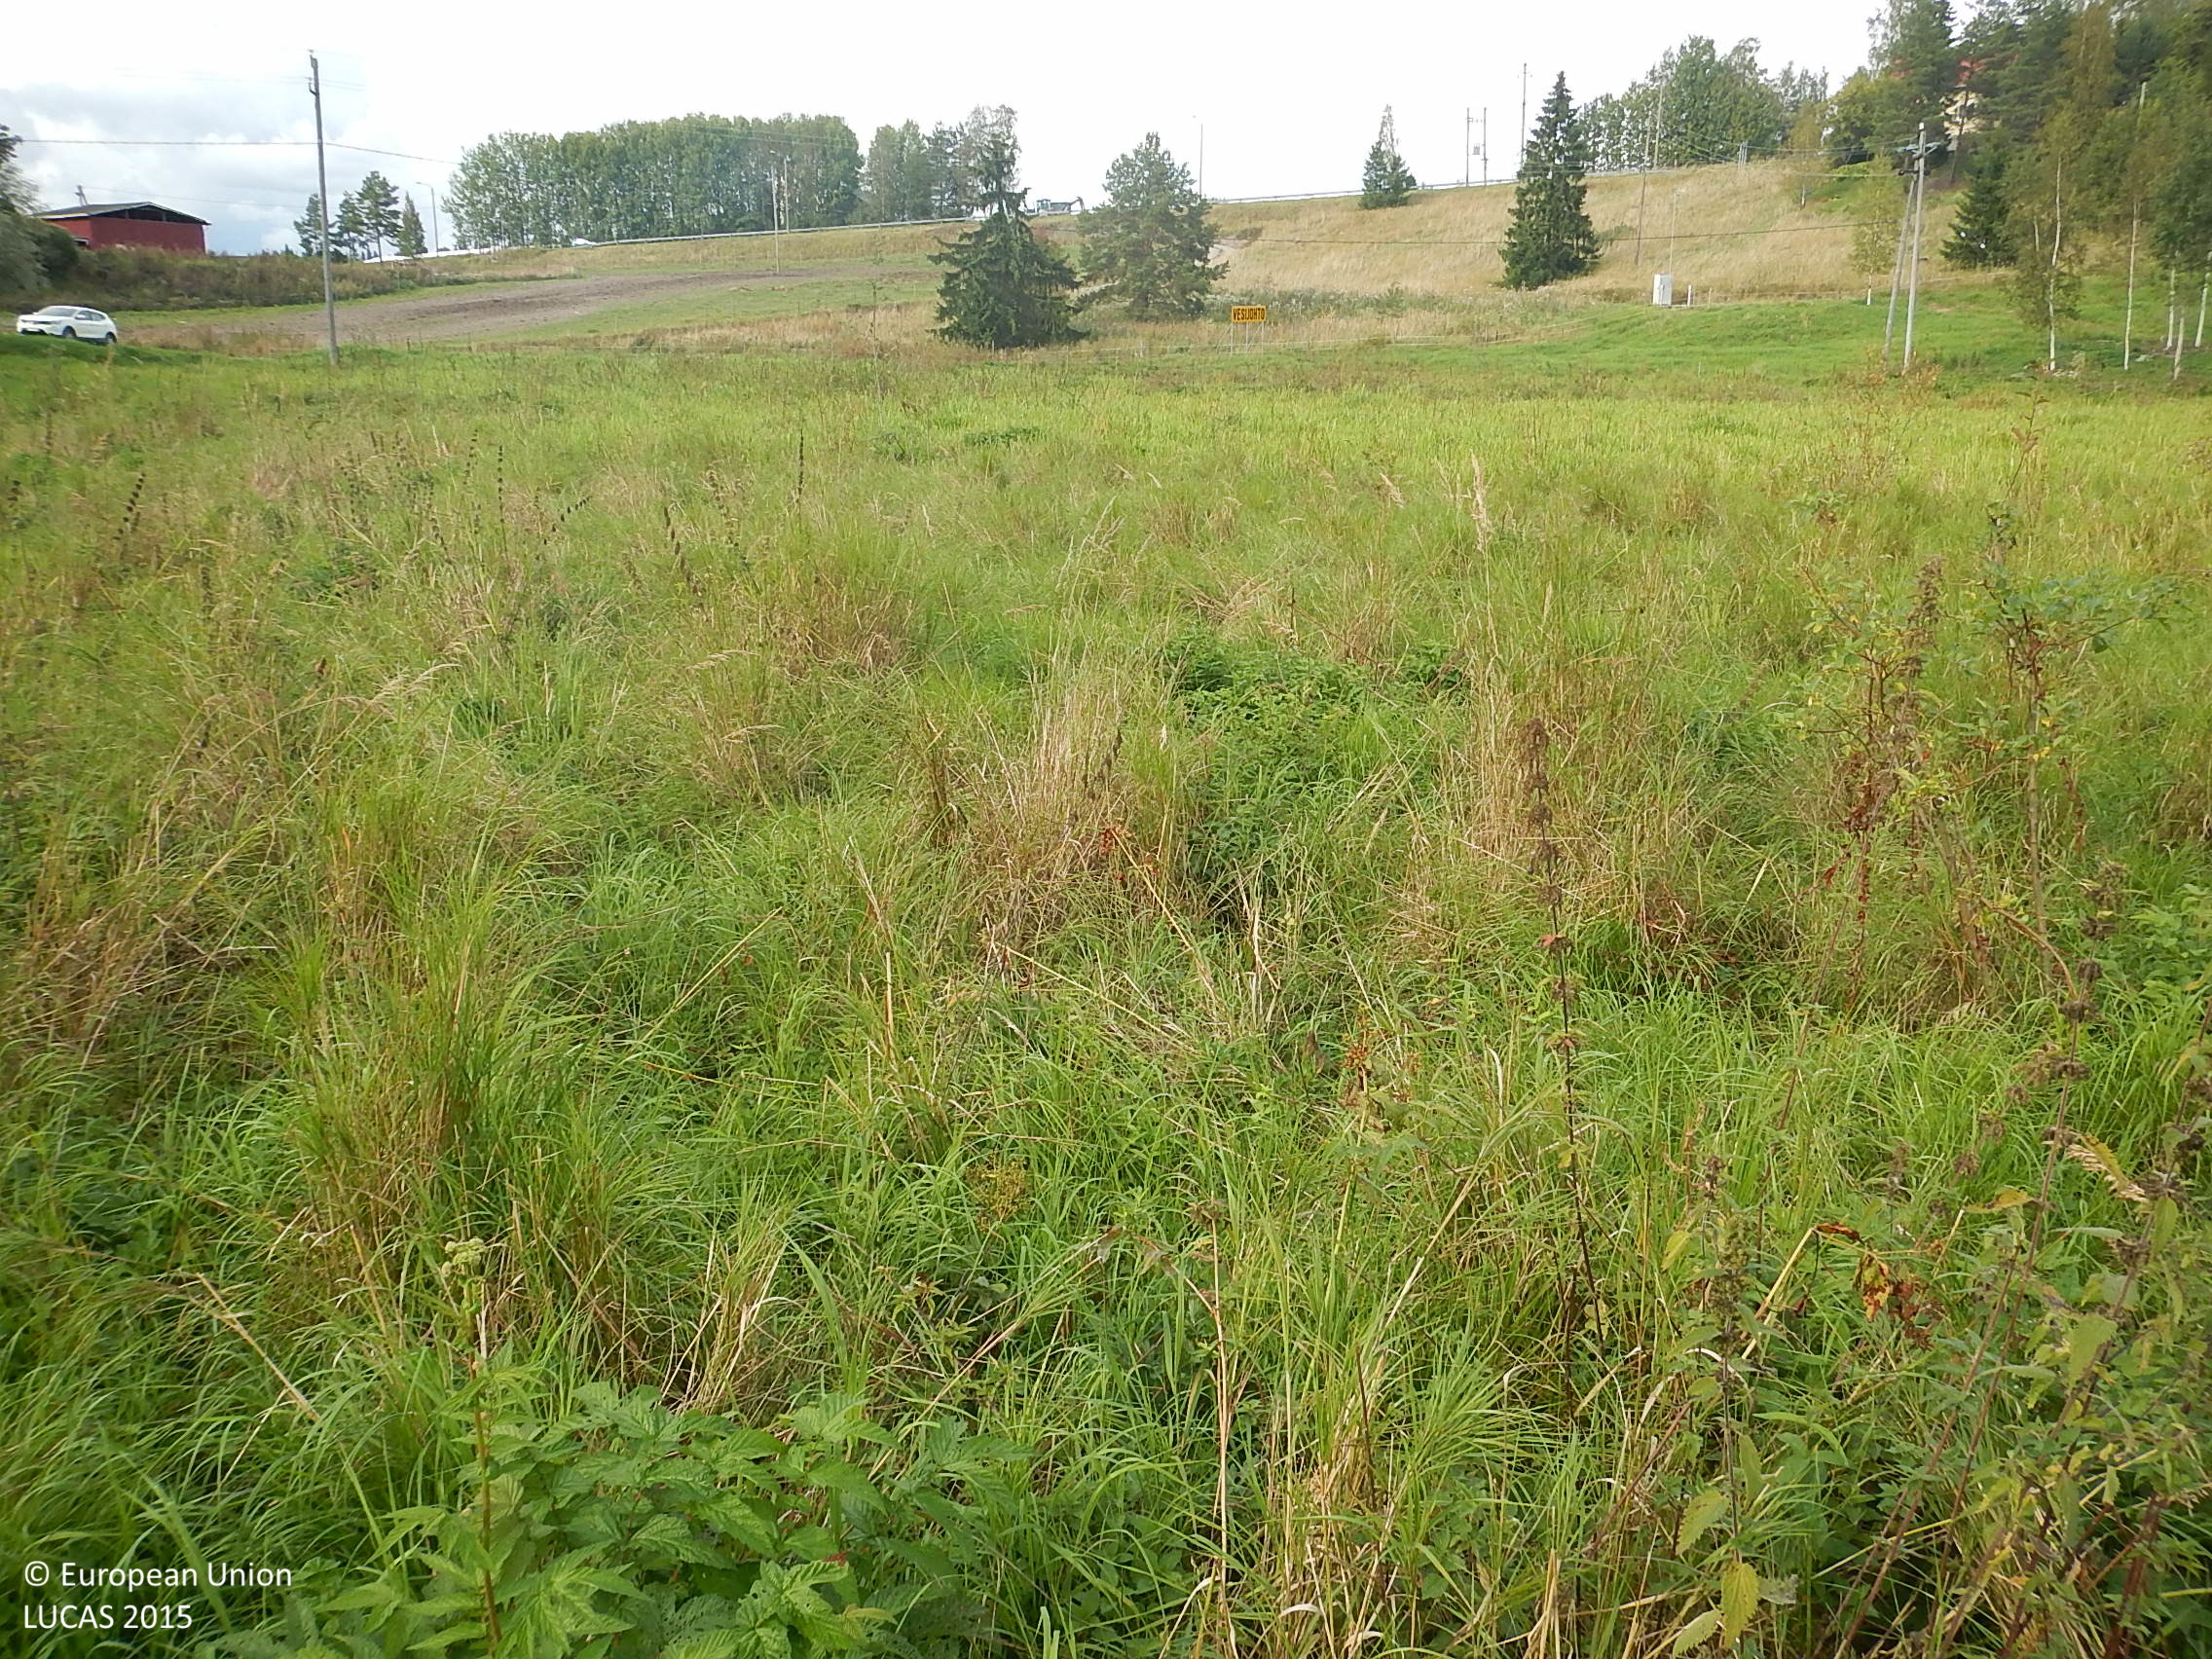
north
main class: Grassland
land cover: Grassland without tree/shrub cover
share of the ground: > 75 %
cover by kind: herbaceous plants 100 %
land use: Agriculture (excluding fallow land and kitchen gardens)
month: September
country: FI
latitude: 61.5162
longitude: 22.9838
